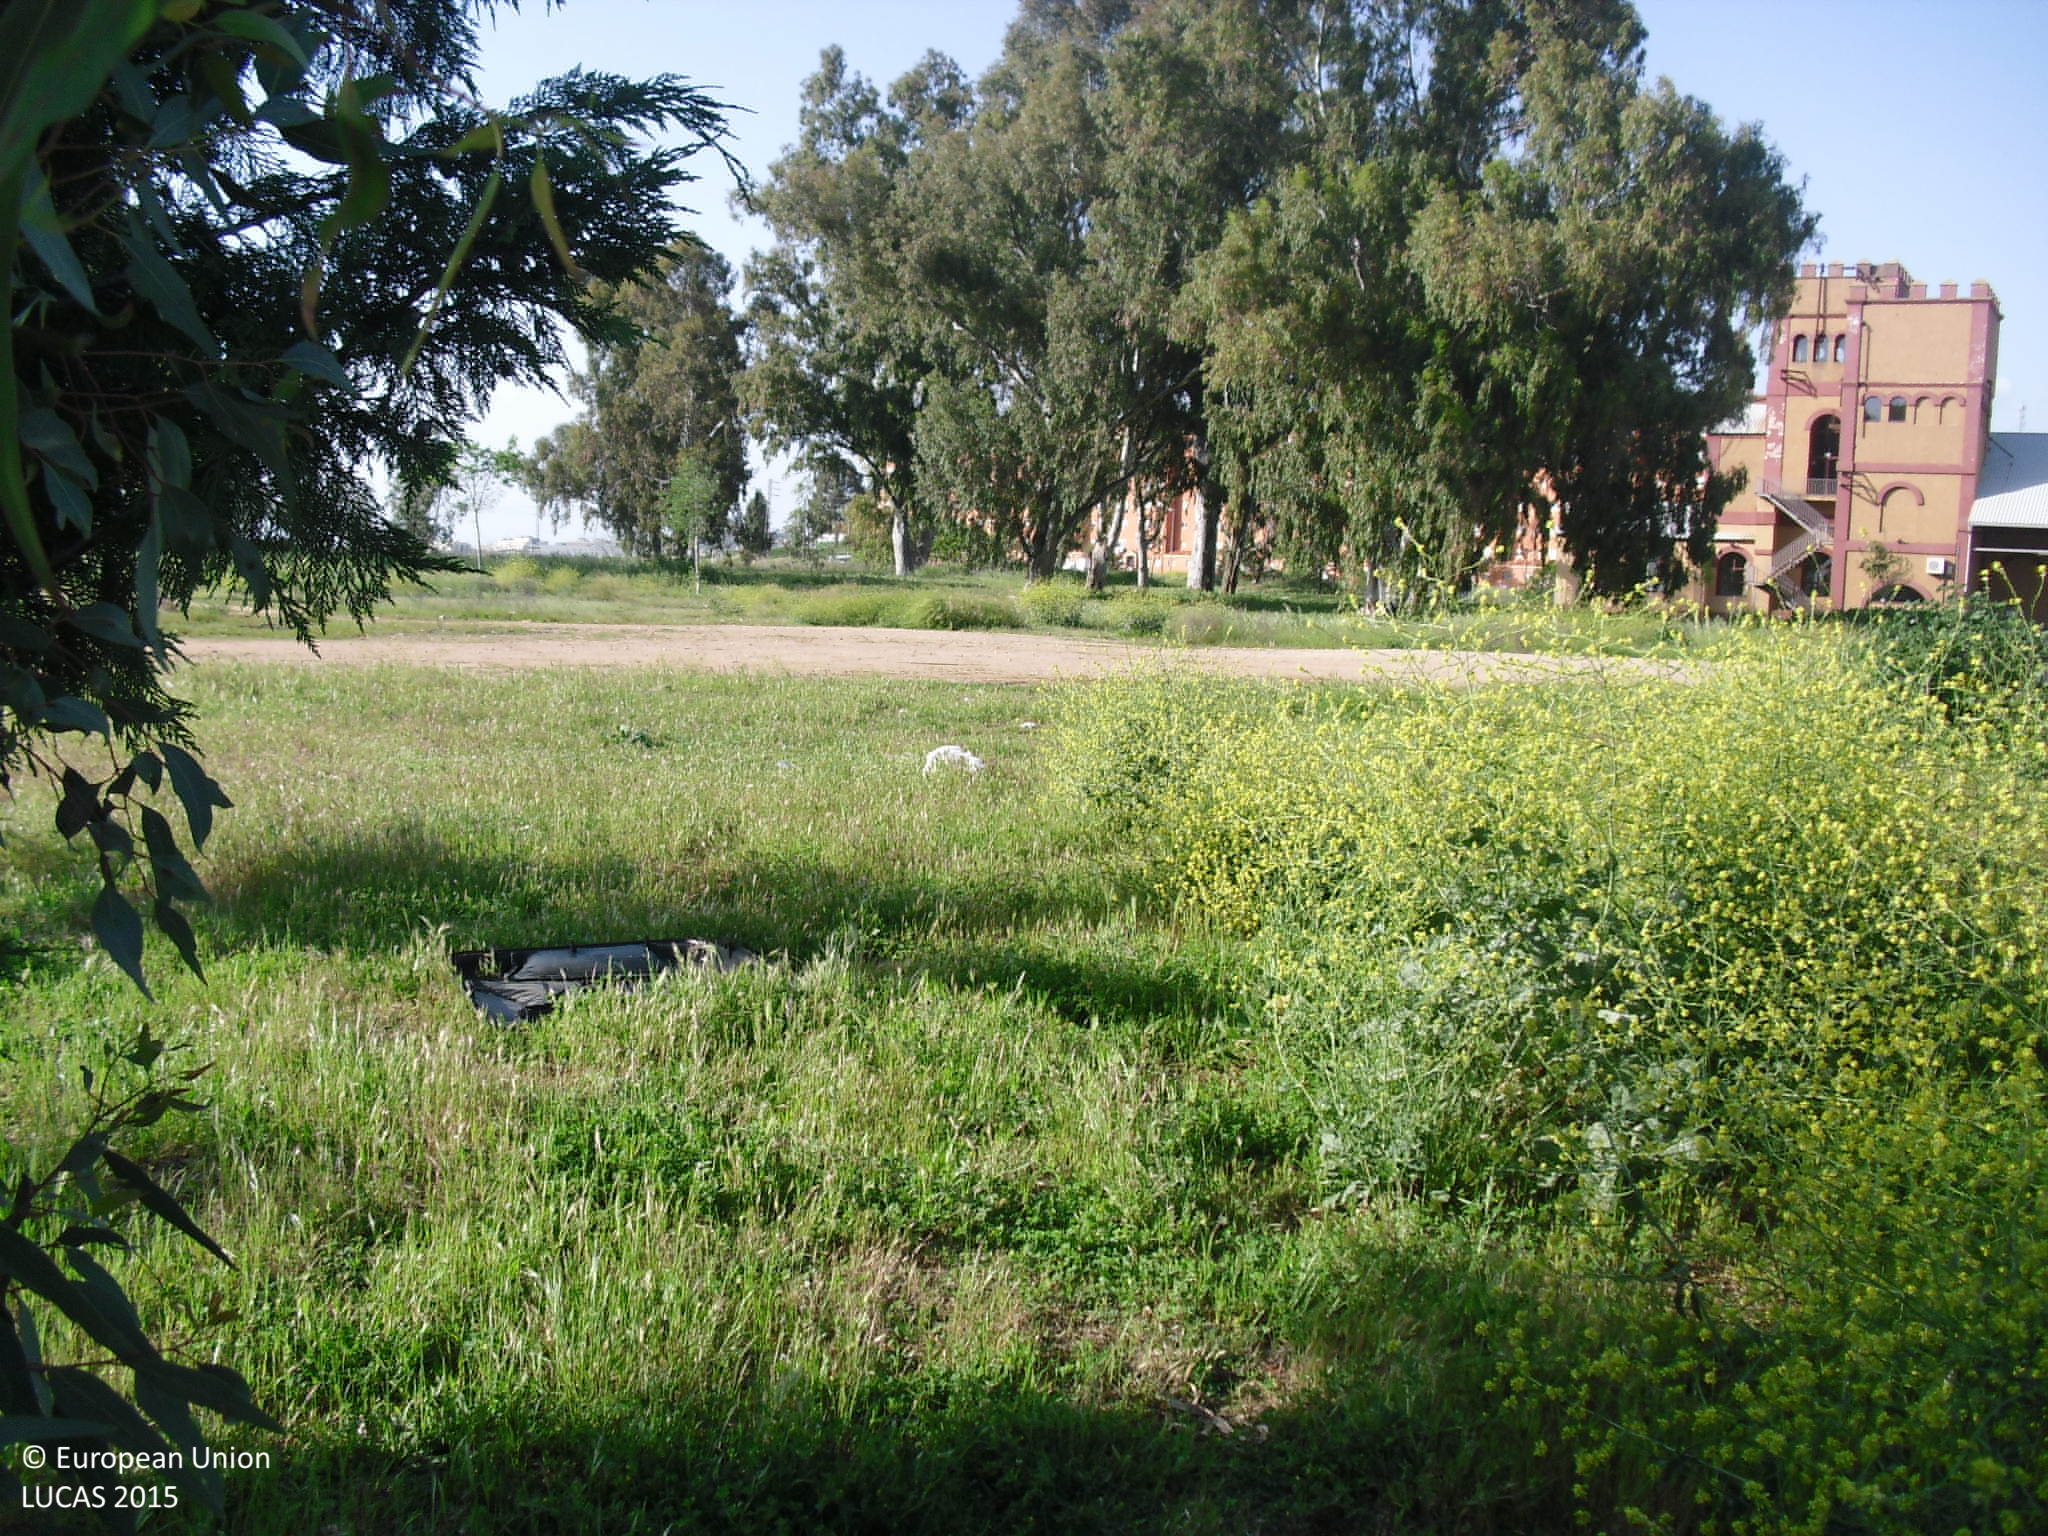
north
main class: Grassland
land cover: Grassland with sparse tree/shrub cover
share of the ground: > 75 %
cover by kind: herbaceous plants 95 %, broadleaved forest trees 5 %
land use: Abandoned areas
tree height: < 5 m
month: April
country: ES
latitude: 39.4486
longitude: -6.3946
